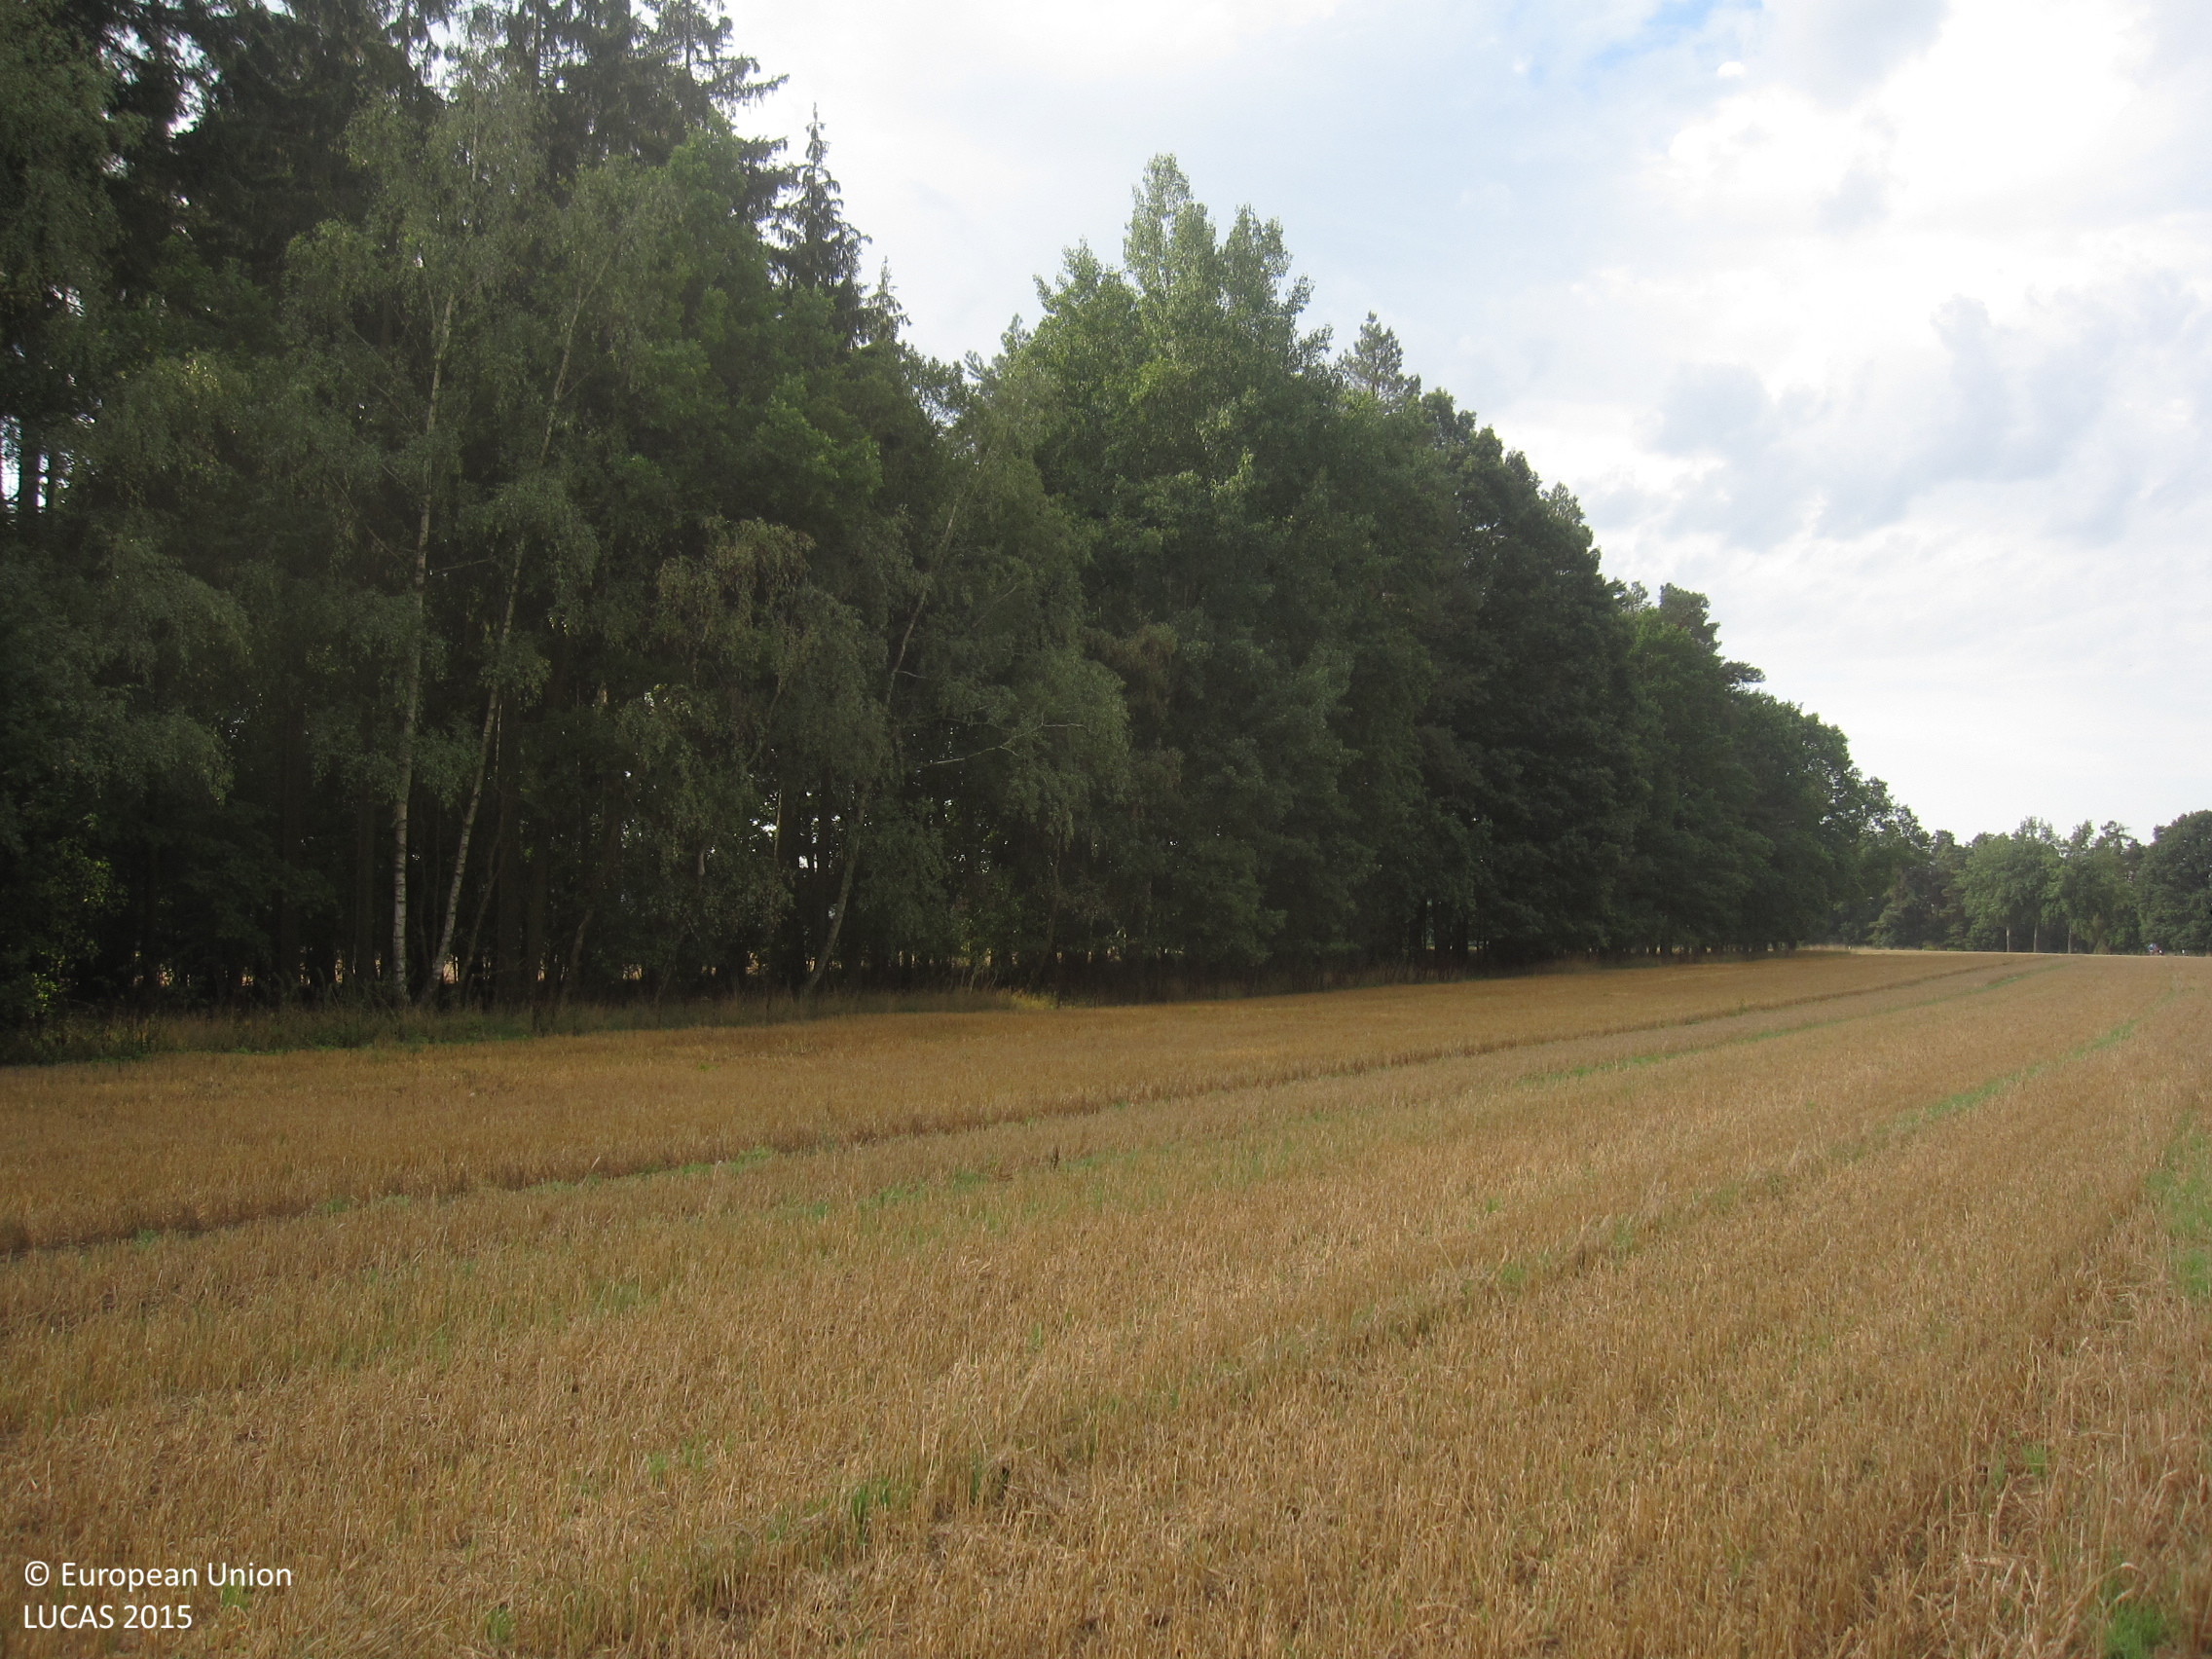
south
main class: Cropland
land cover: Common wheat
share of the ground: 50 - 75 %
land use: Agriculture (excluding fallow land and kitchen gardens)
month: August
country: DE
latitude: 50.7962
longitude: 12.0001
